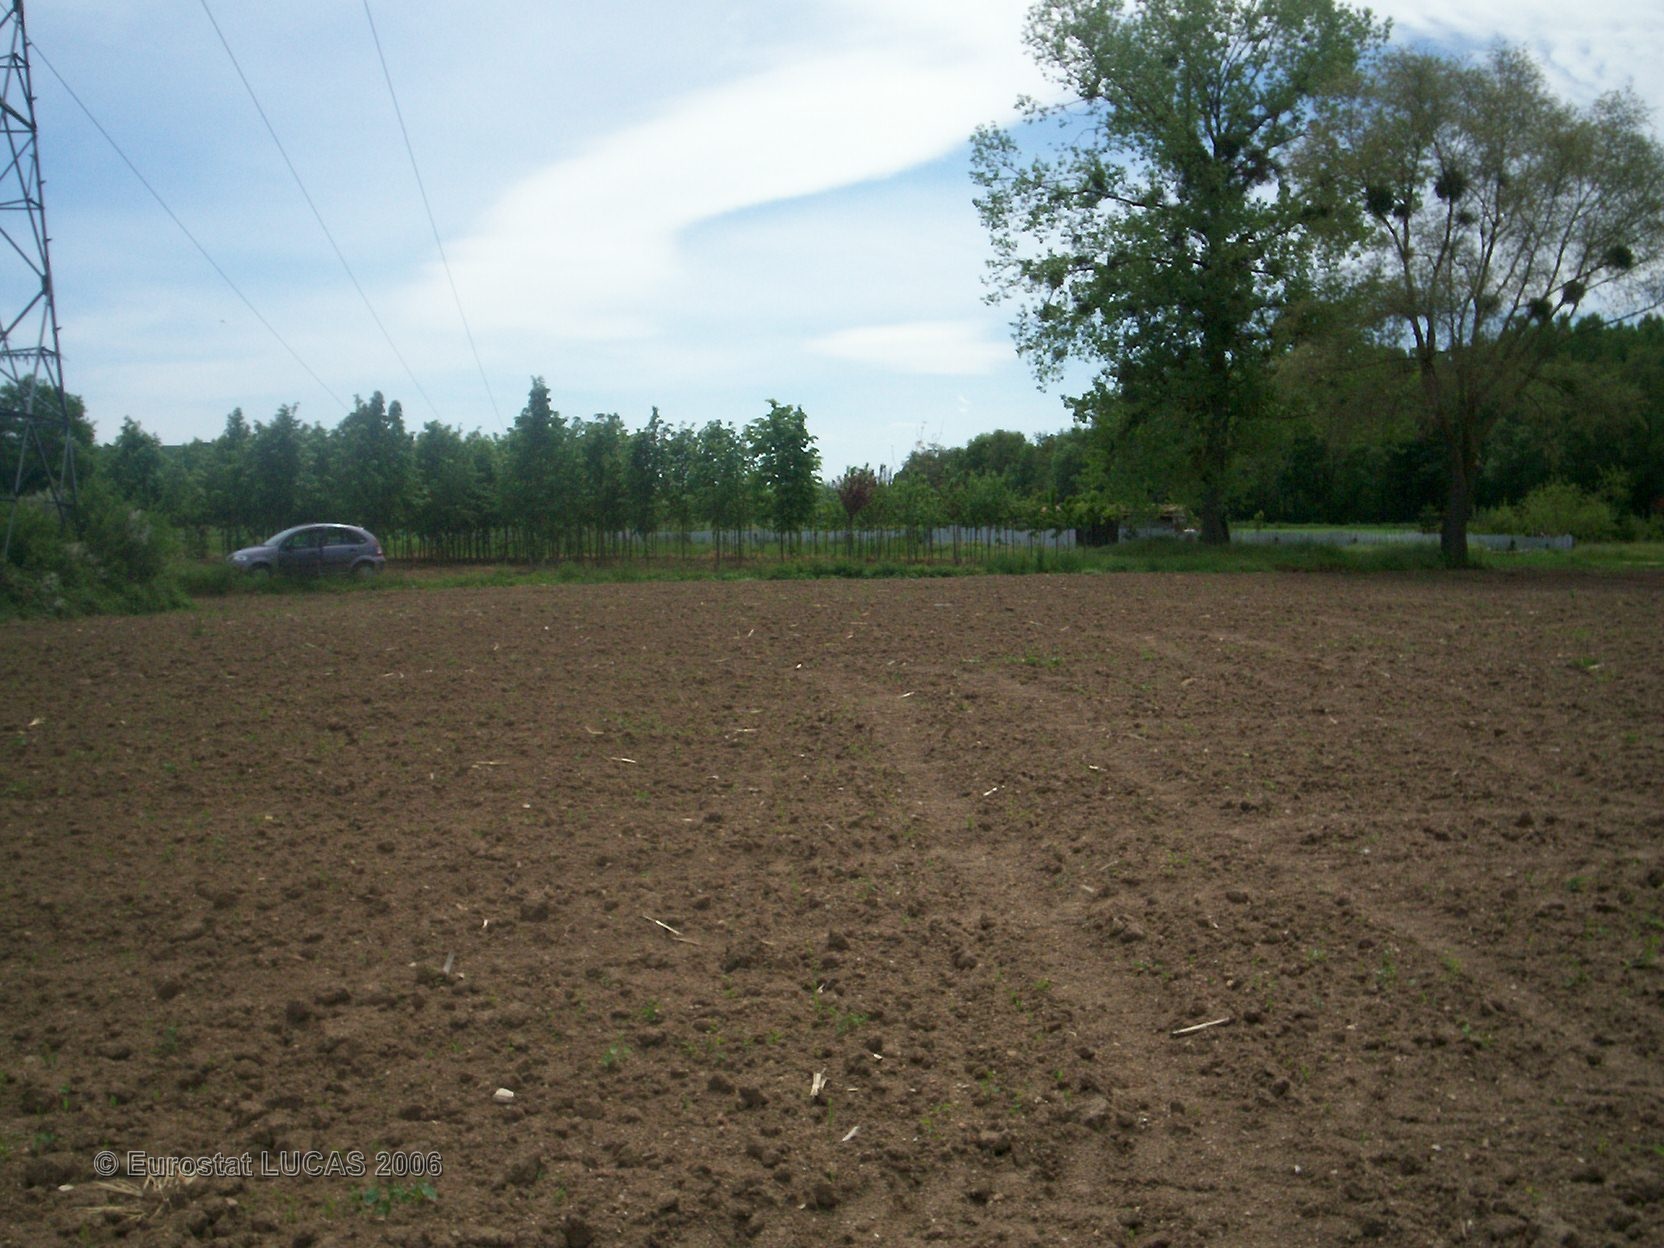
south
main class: Cropland
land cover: Maize
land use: Agriculture (excluding fallow land and kitchen gardens)
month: May
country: FR
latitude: 45.5089
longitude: 3.3070
